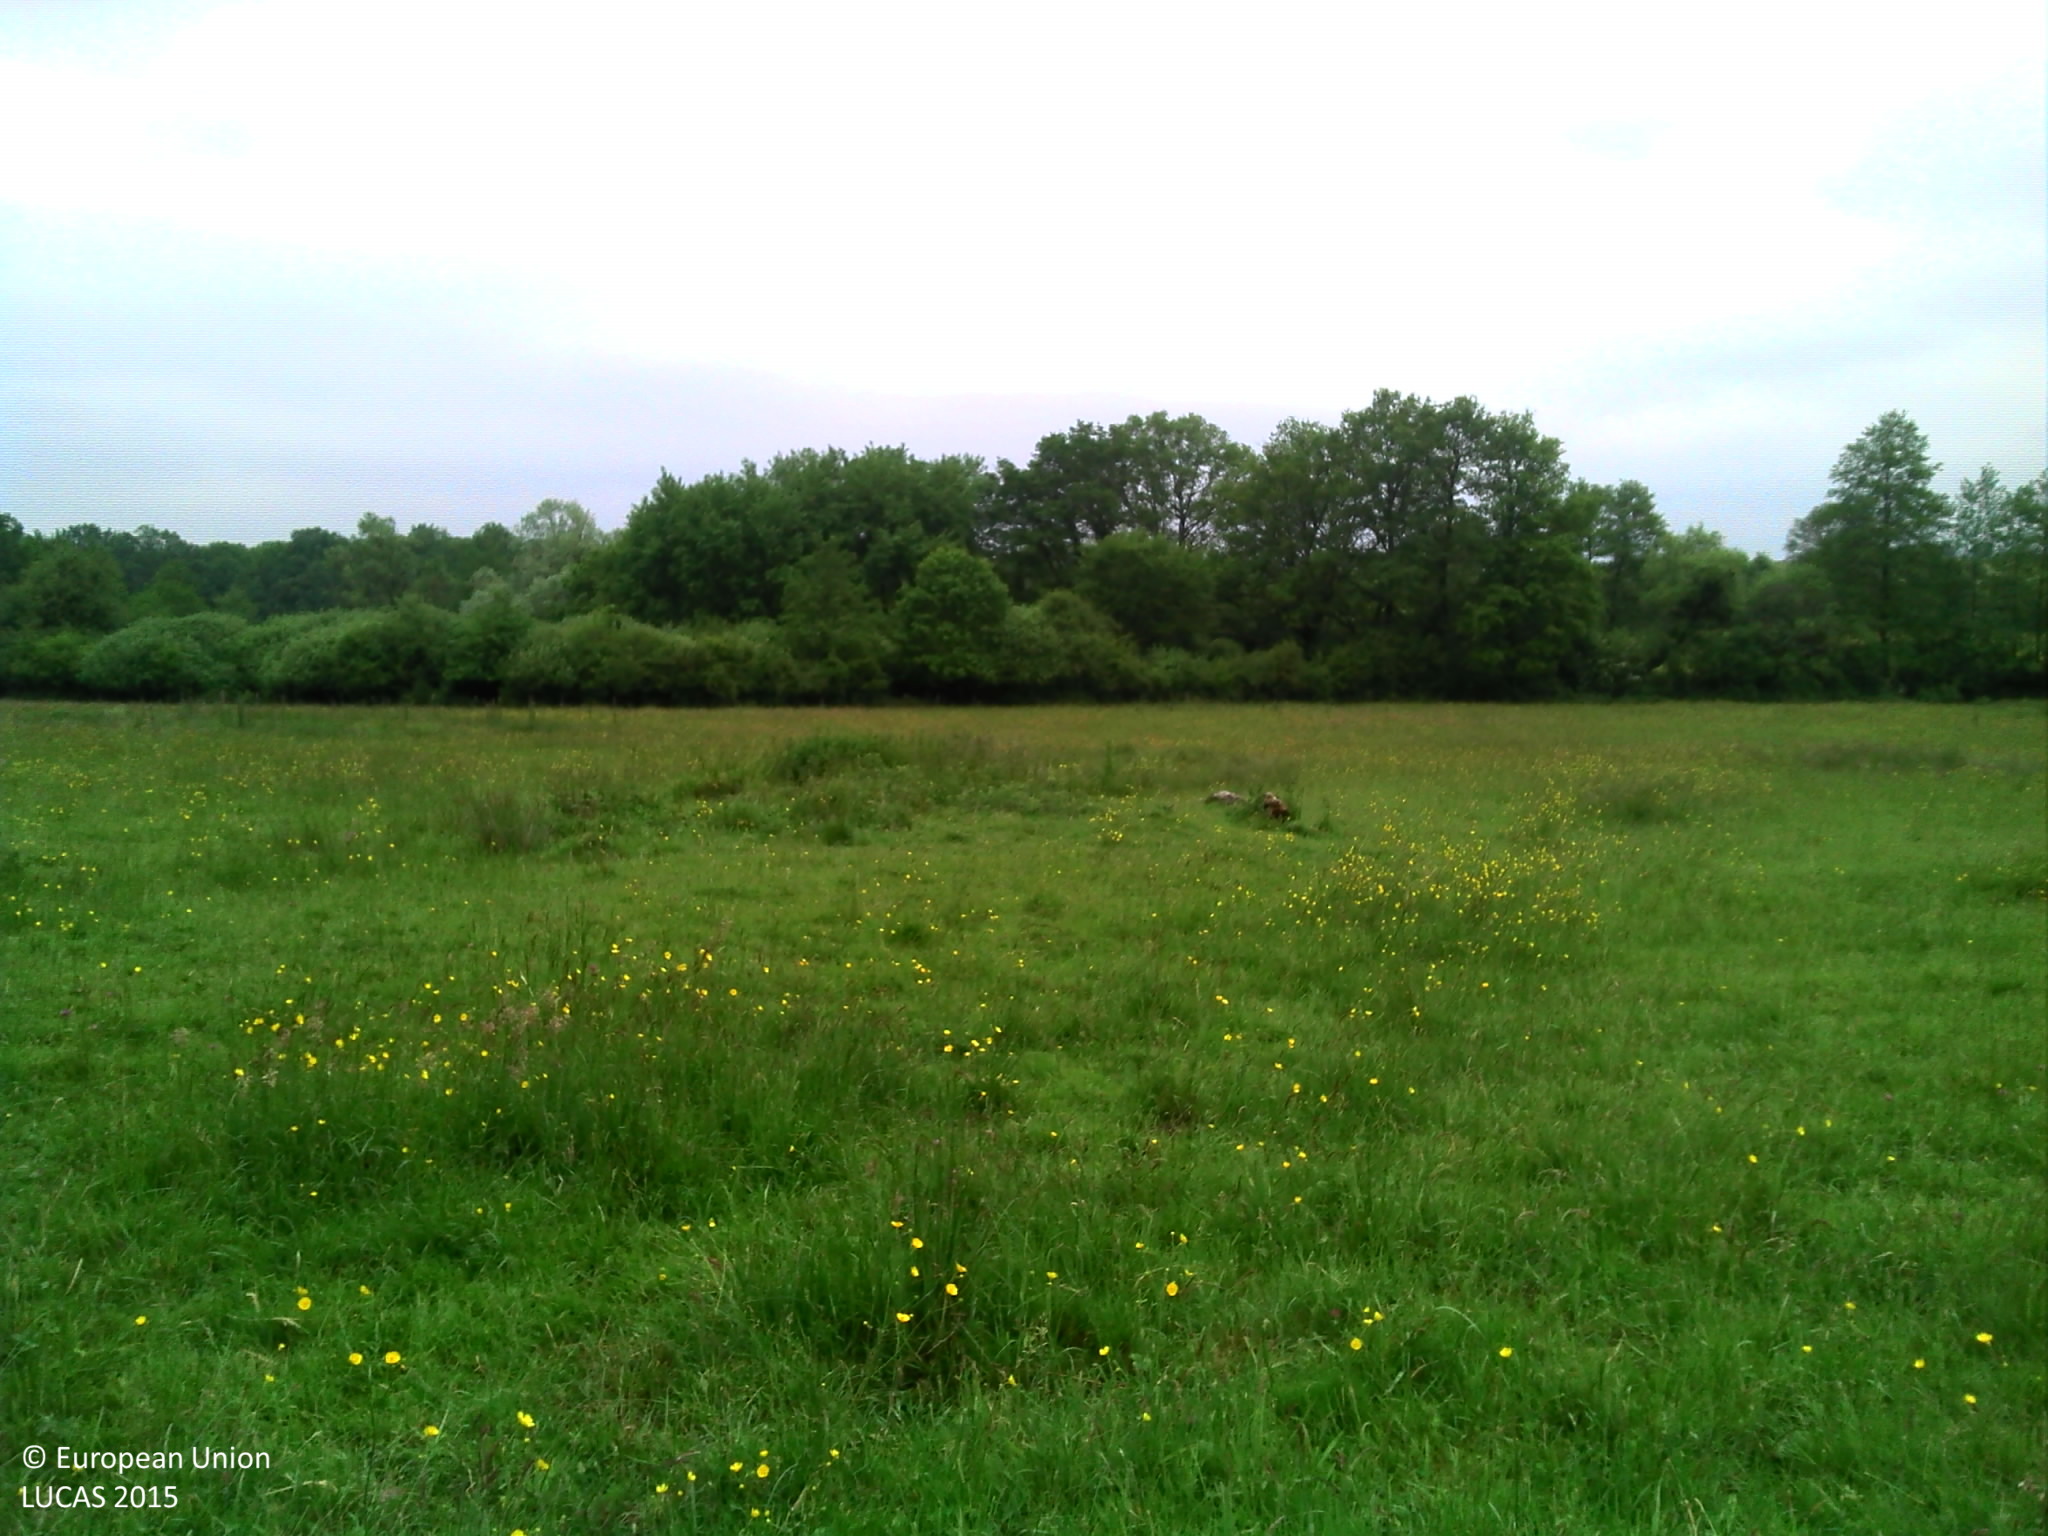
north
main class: Grassland
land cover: Grassland with sparse tree/shrub cover
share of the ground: > 75 %
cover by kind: herbaceous plants 95 %, broadleaved forest trees 5 %
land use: Agriculture (excluding fallow land and kitchen gardens)
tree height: > 5 m
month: May
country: FR
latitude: 47.9405
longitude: 6.1587
